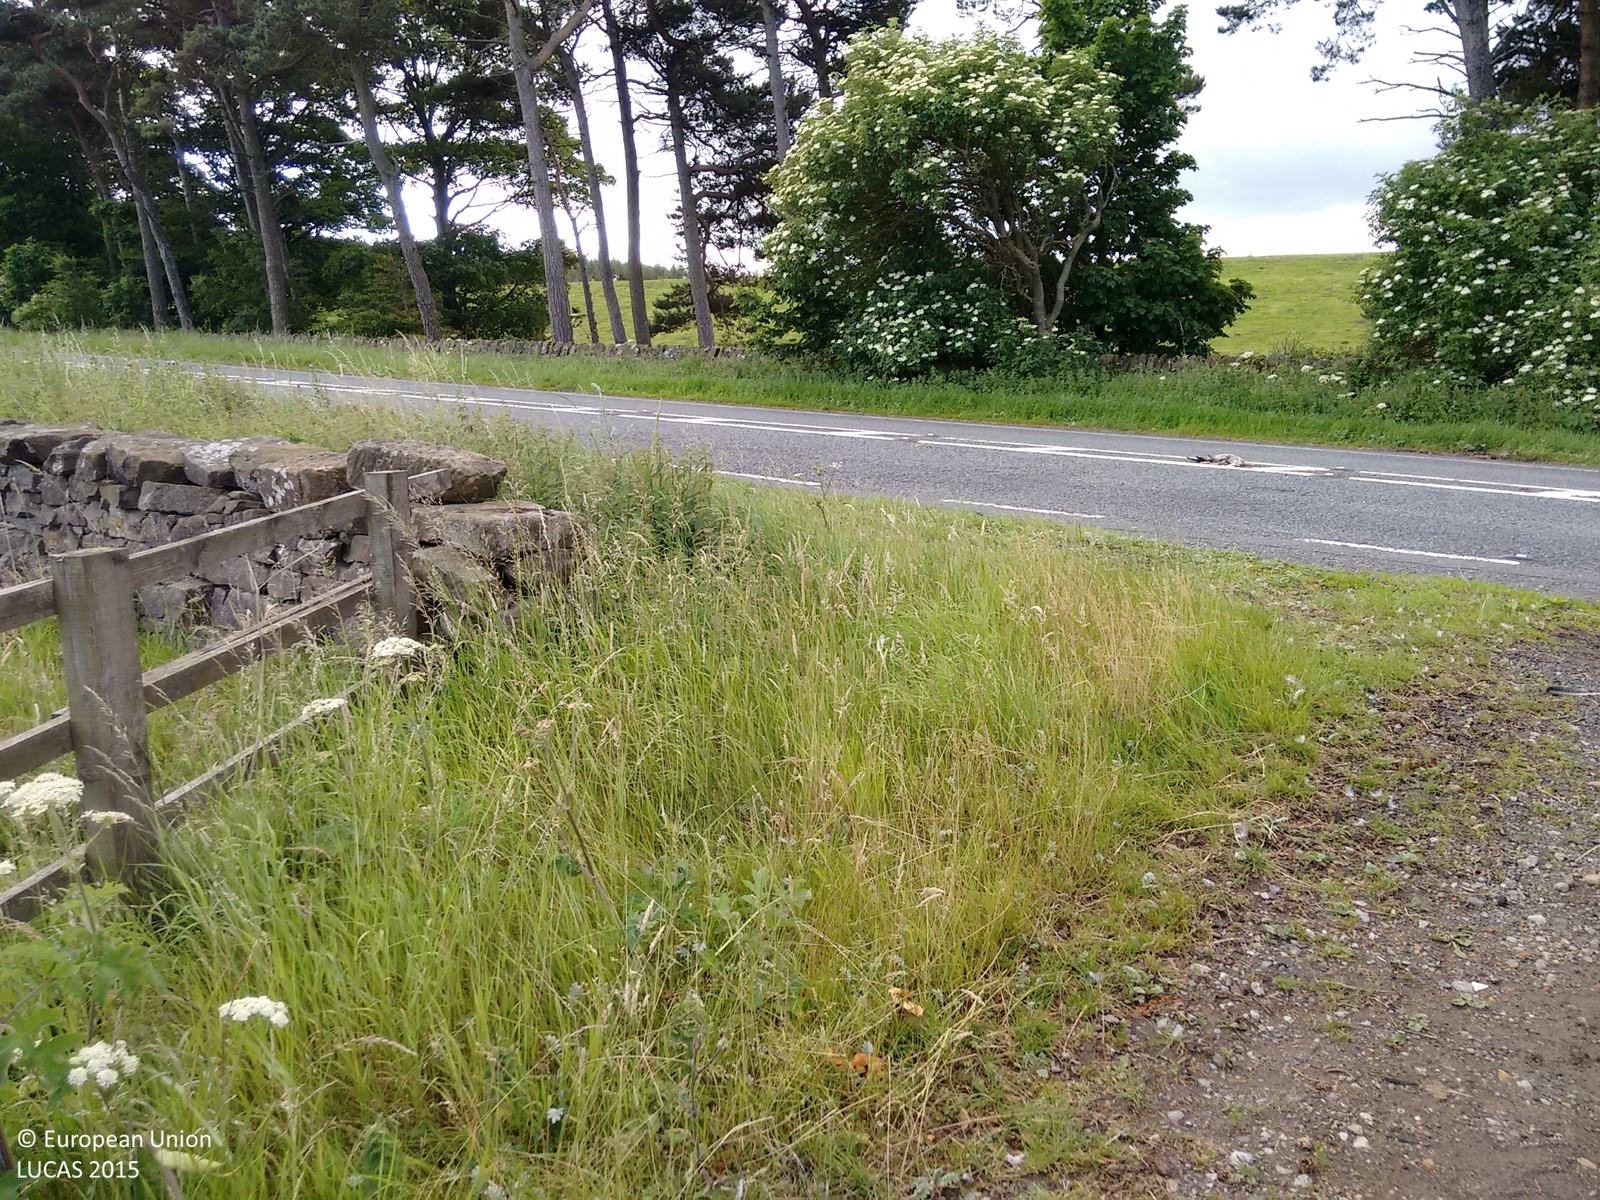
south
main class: Grassland
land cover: Grassland without tree/shrub cover
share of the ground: > 75 %
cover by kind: herbaceous plants 100 %
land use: Agriculture (excluding fallow land and kitchen gardens)
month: July
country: GB
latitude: 54.5181
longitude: -0.9631
